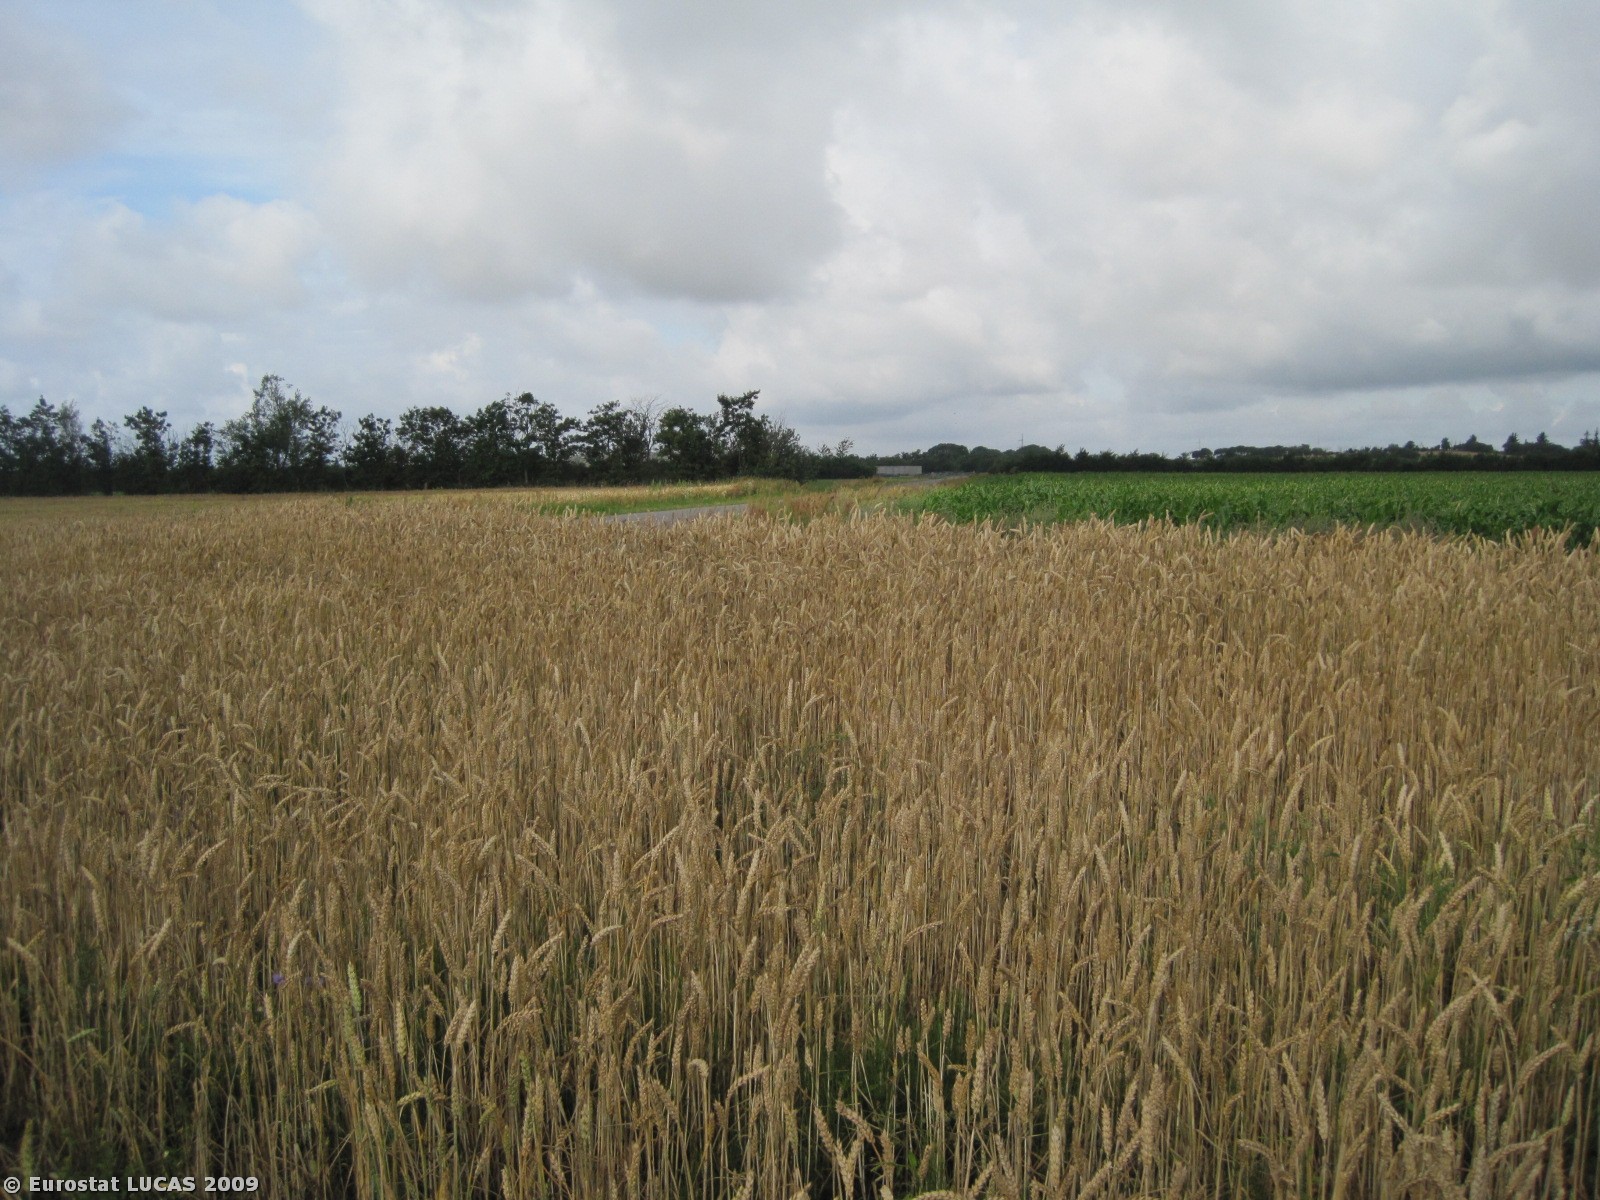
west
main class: Cropland
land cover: Common wheat
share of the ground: > 75 %
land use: Agriculture (excluding fallow land and kitchen gardens)
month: July
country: DK
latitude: 57.0483
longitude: 9.2264
